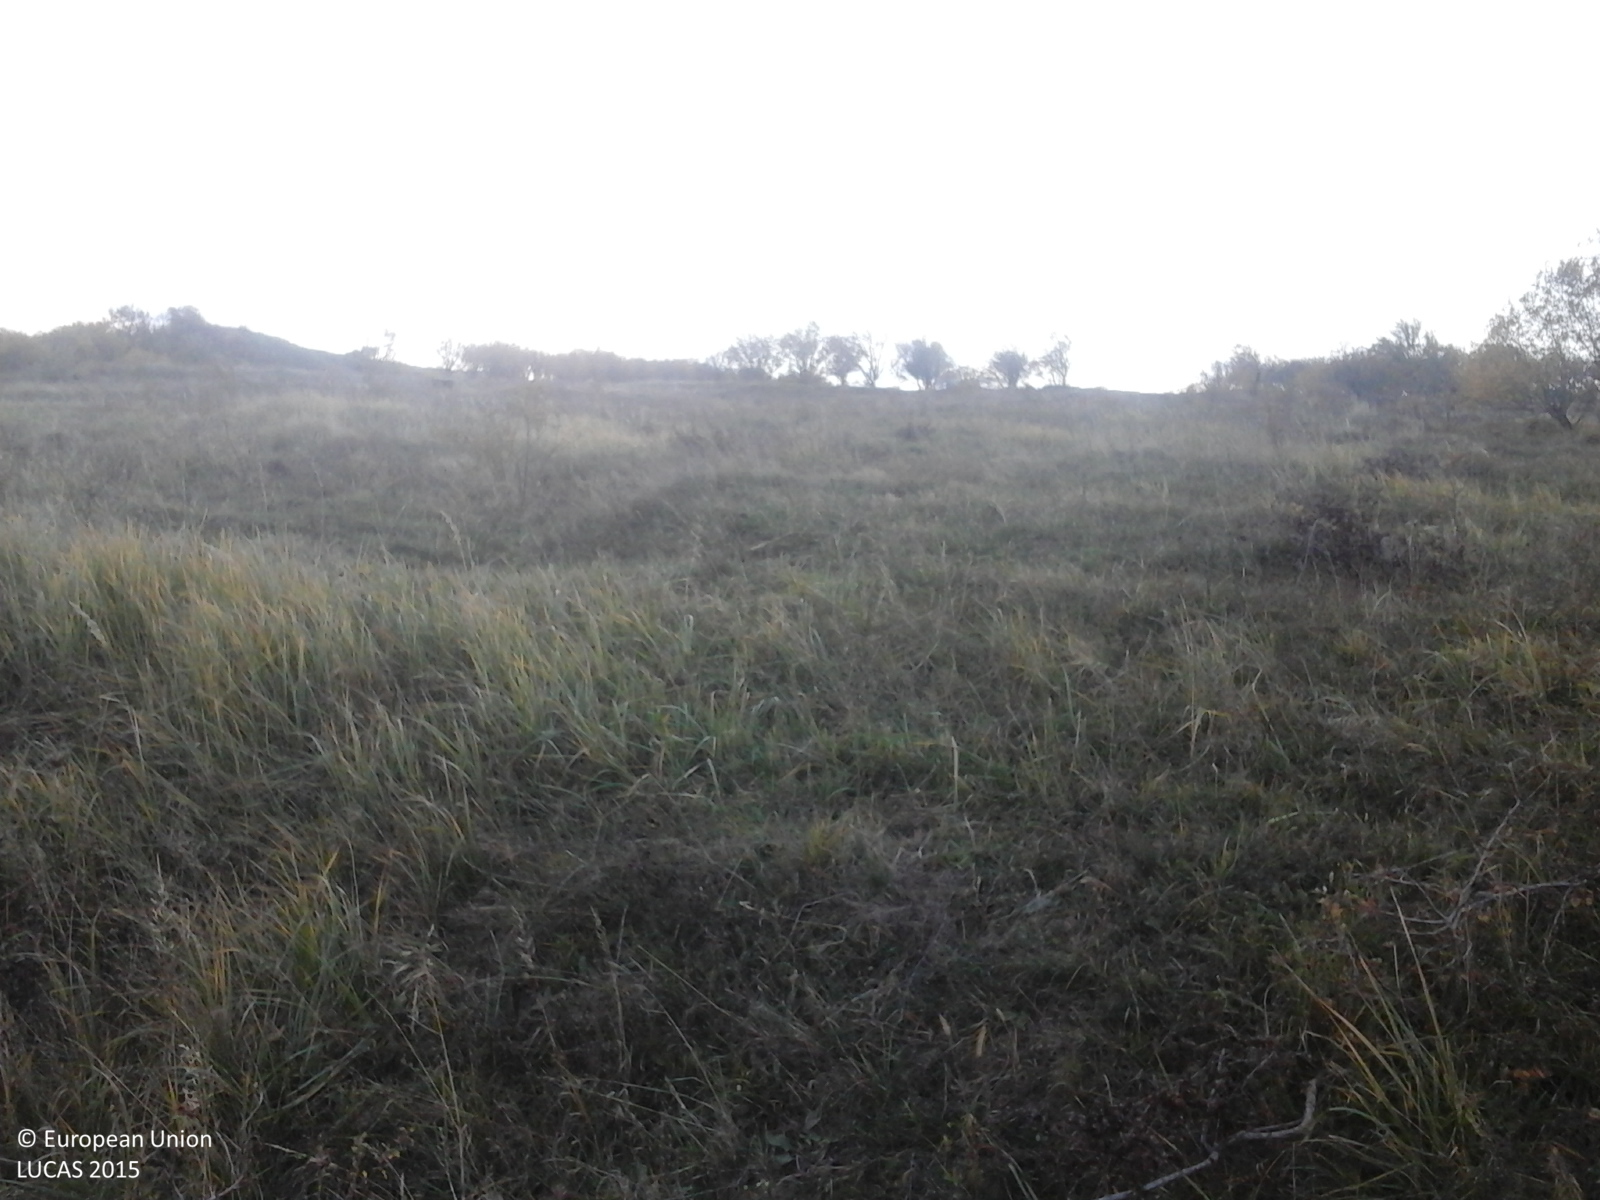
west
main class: Grassland
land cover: Grassland with sparse tree/shrub cover
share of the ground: > 75 %
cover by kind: herbaceous plants 85 %, shrubs 10 %, broadleaved forest trees 5 %
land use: Agriculture (excluding fallow land and kitchen gardens)
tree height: < 5 m
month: October
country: RO
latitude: 45.5154
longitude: 26.9719
